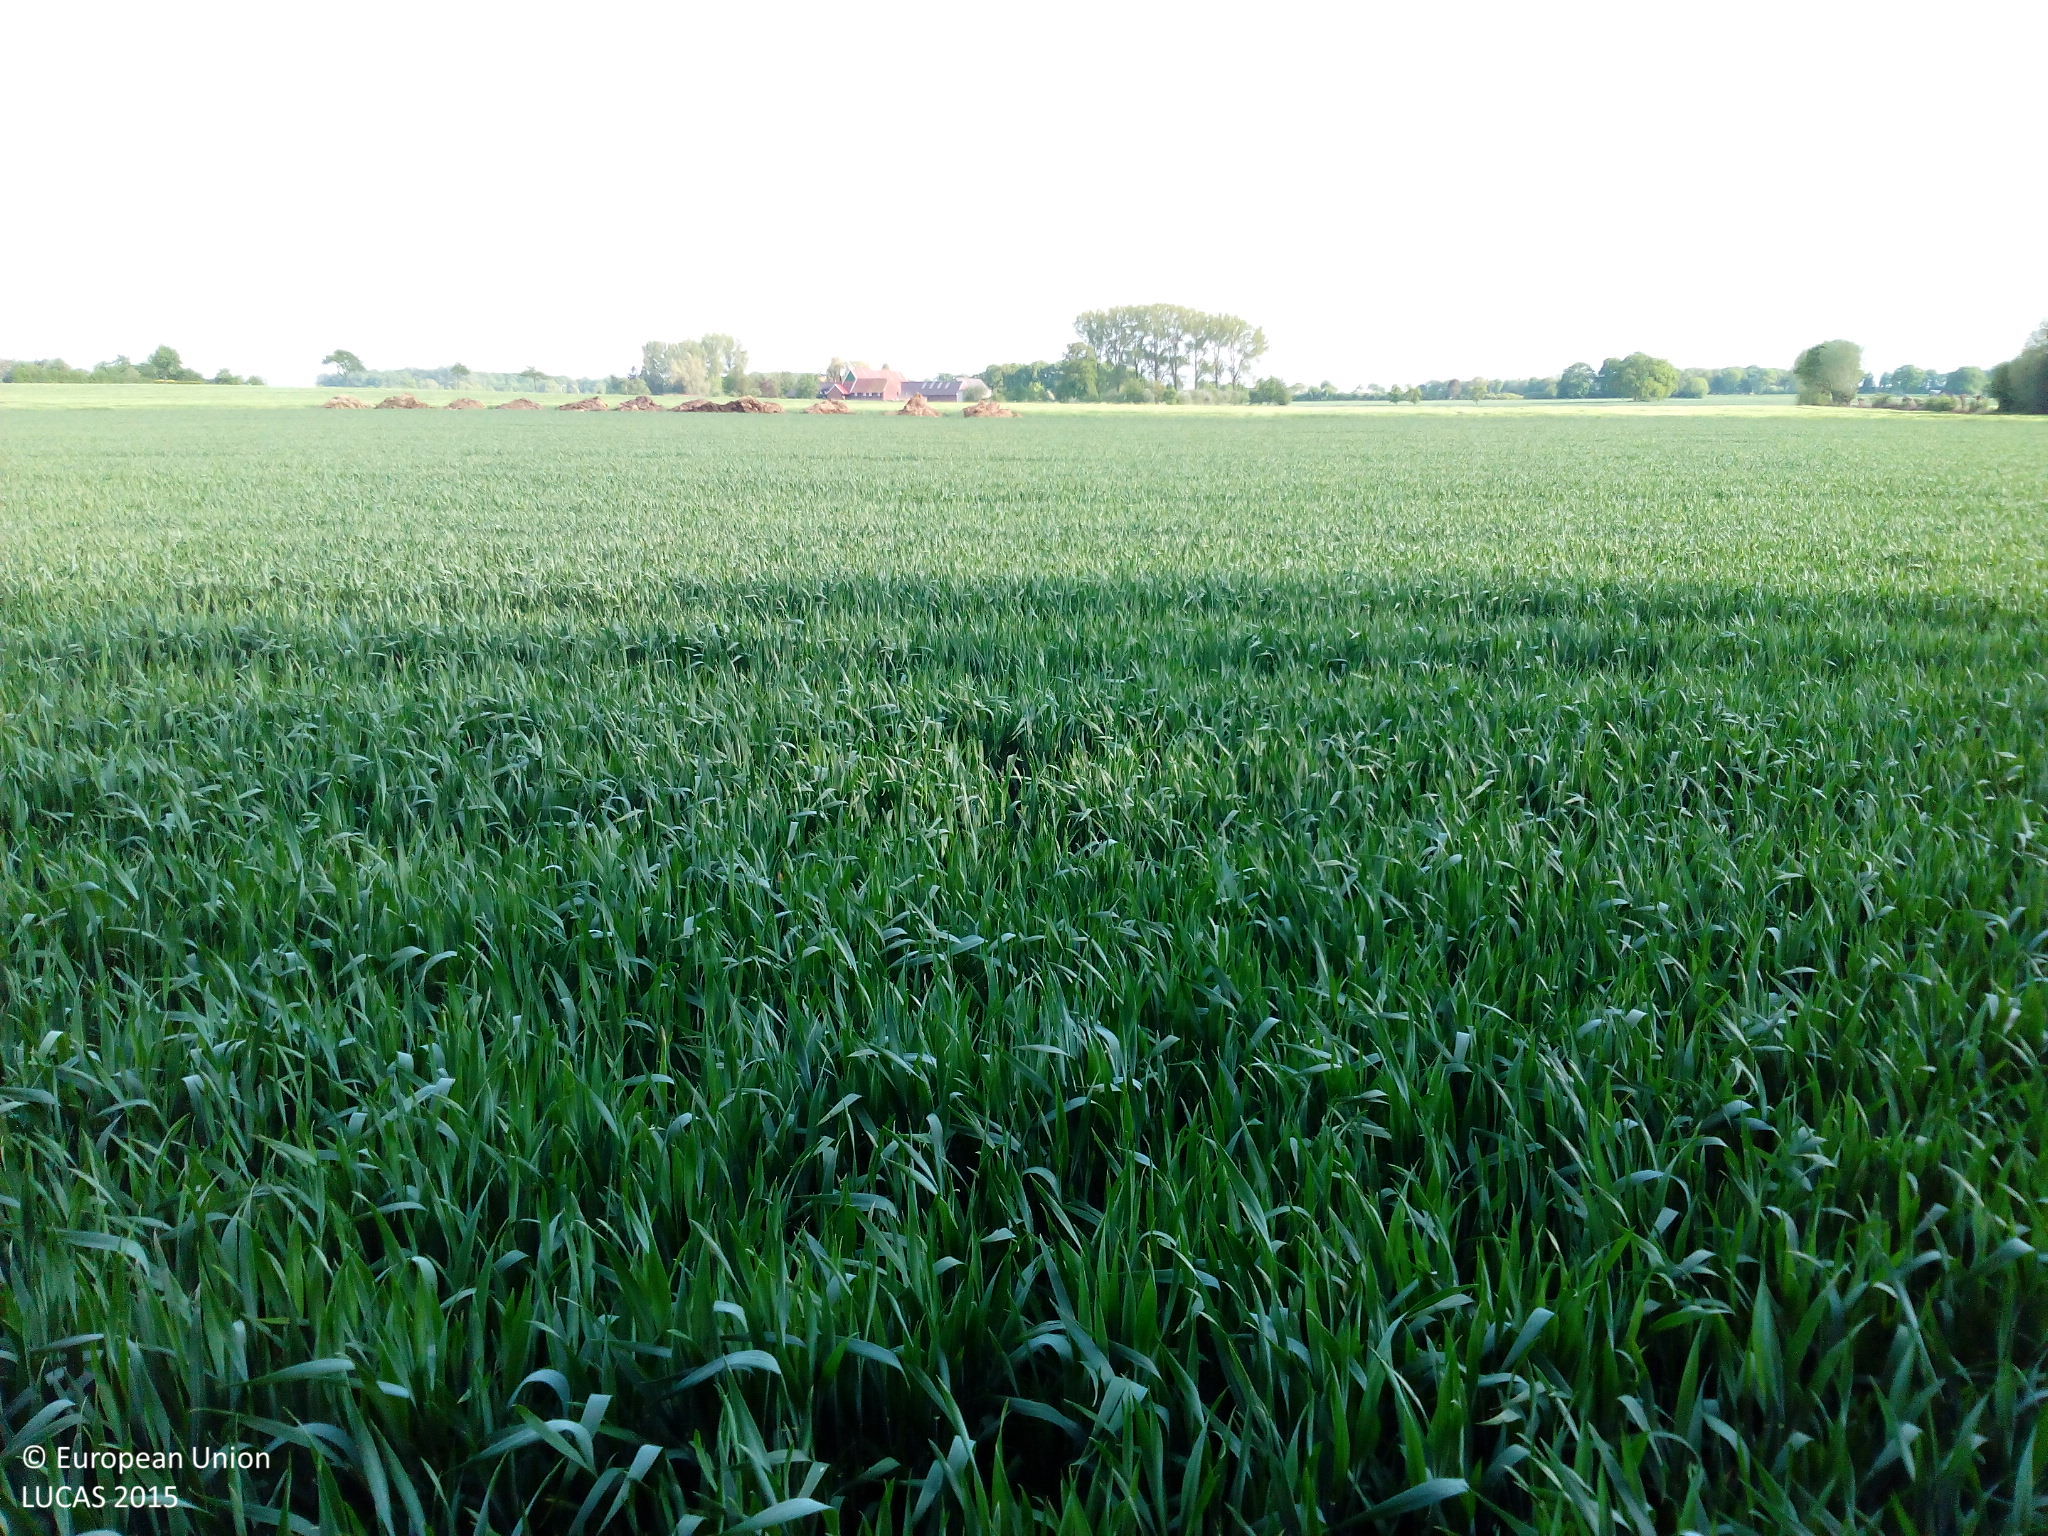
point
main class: Cropland
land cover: Common wheat
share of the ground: > 75 %
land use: Agriculture (excluding fallow land and kitchen gardens)
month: May
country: DE
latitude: 51.8564
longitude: 7.9532
